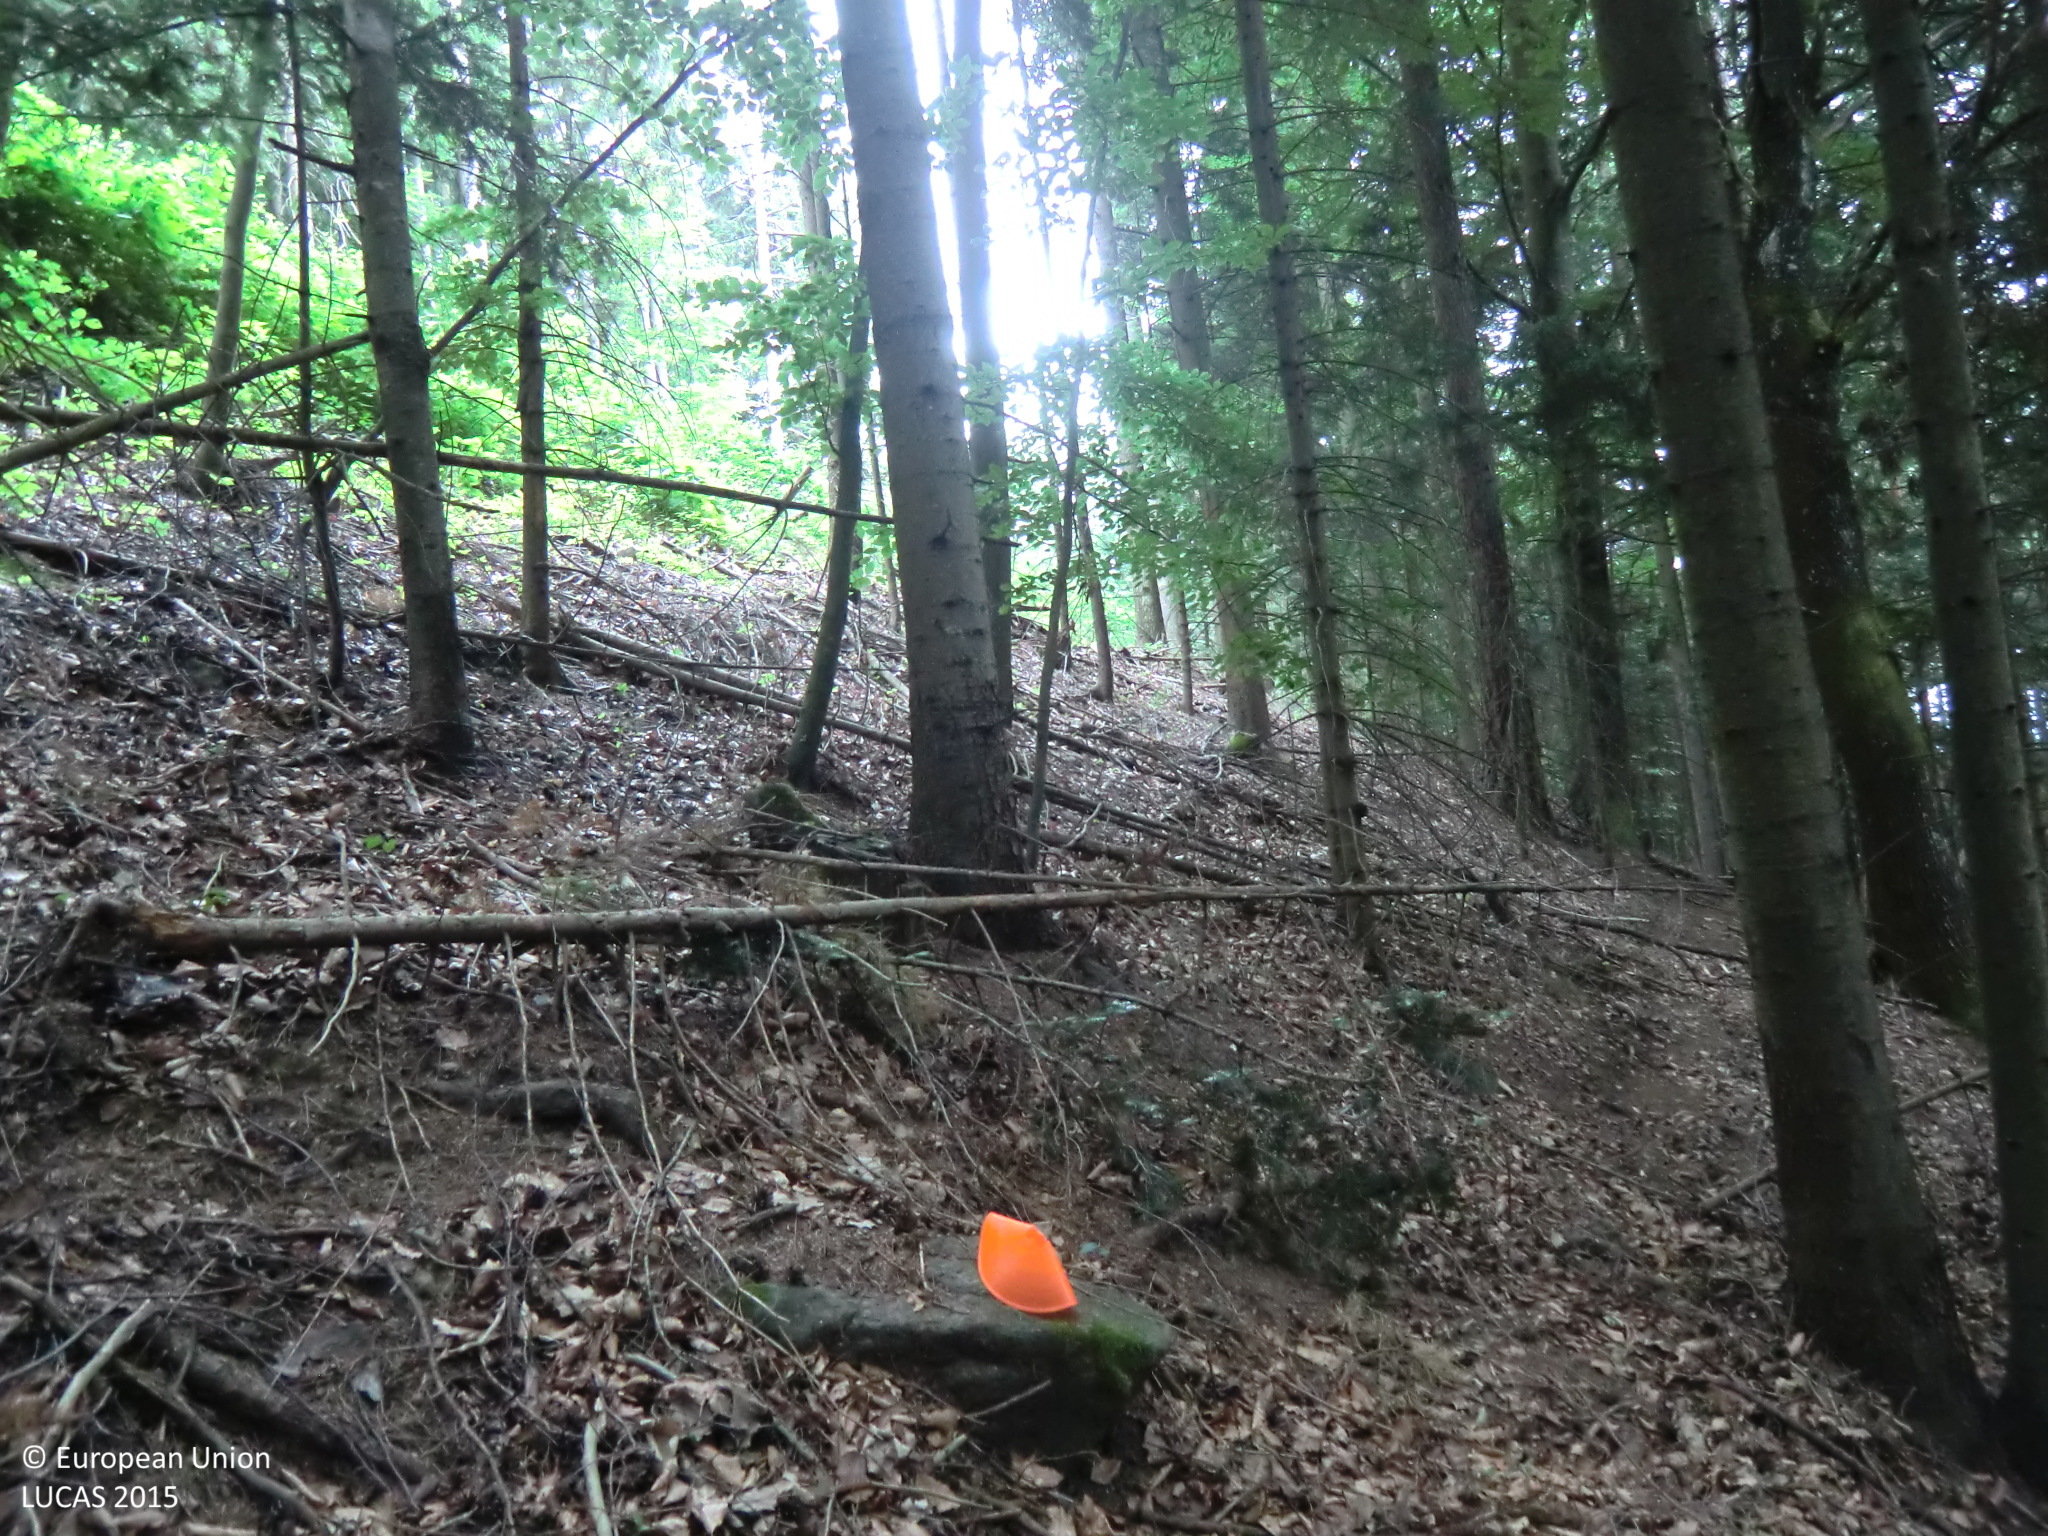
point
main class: Woodland
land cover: Spruce dominated mixed woodland
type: hemiboreal forest and nemoral coniferous forest and mixed broadleaved-coniferous forest
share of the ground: > 75 %
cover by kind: coniferous forest trees 45 %, broadleaved forest trees 45 %, unconsolidated bare surface 10 %
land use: Forestry
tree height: > 5 m
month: June
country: AT
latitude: 47.2616
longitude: 15.7498
